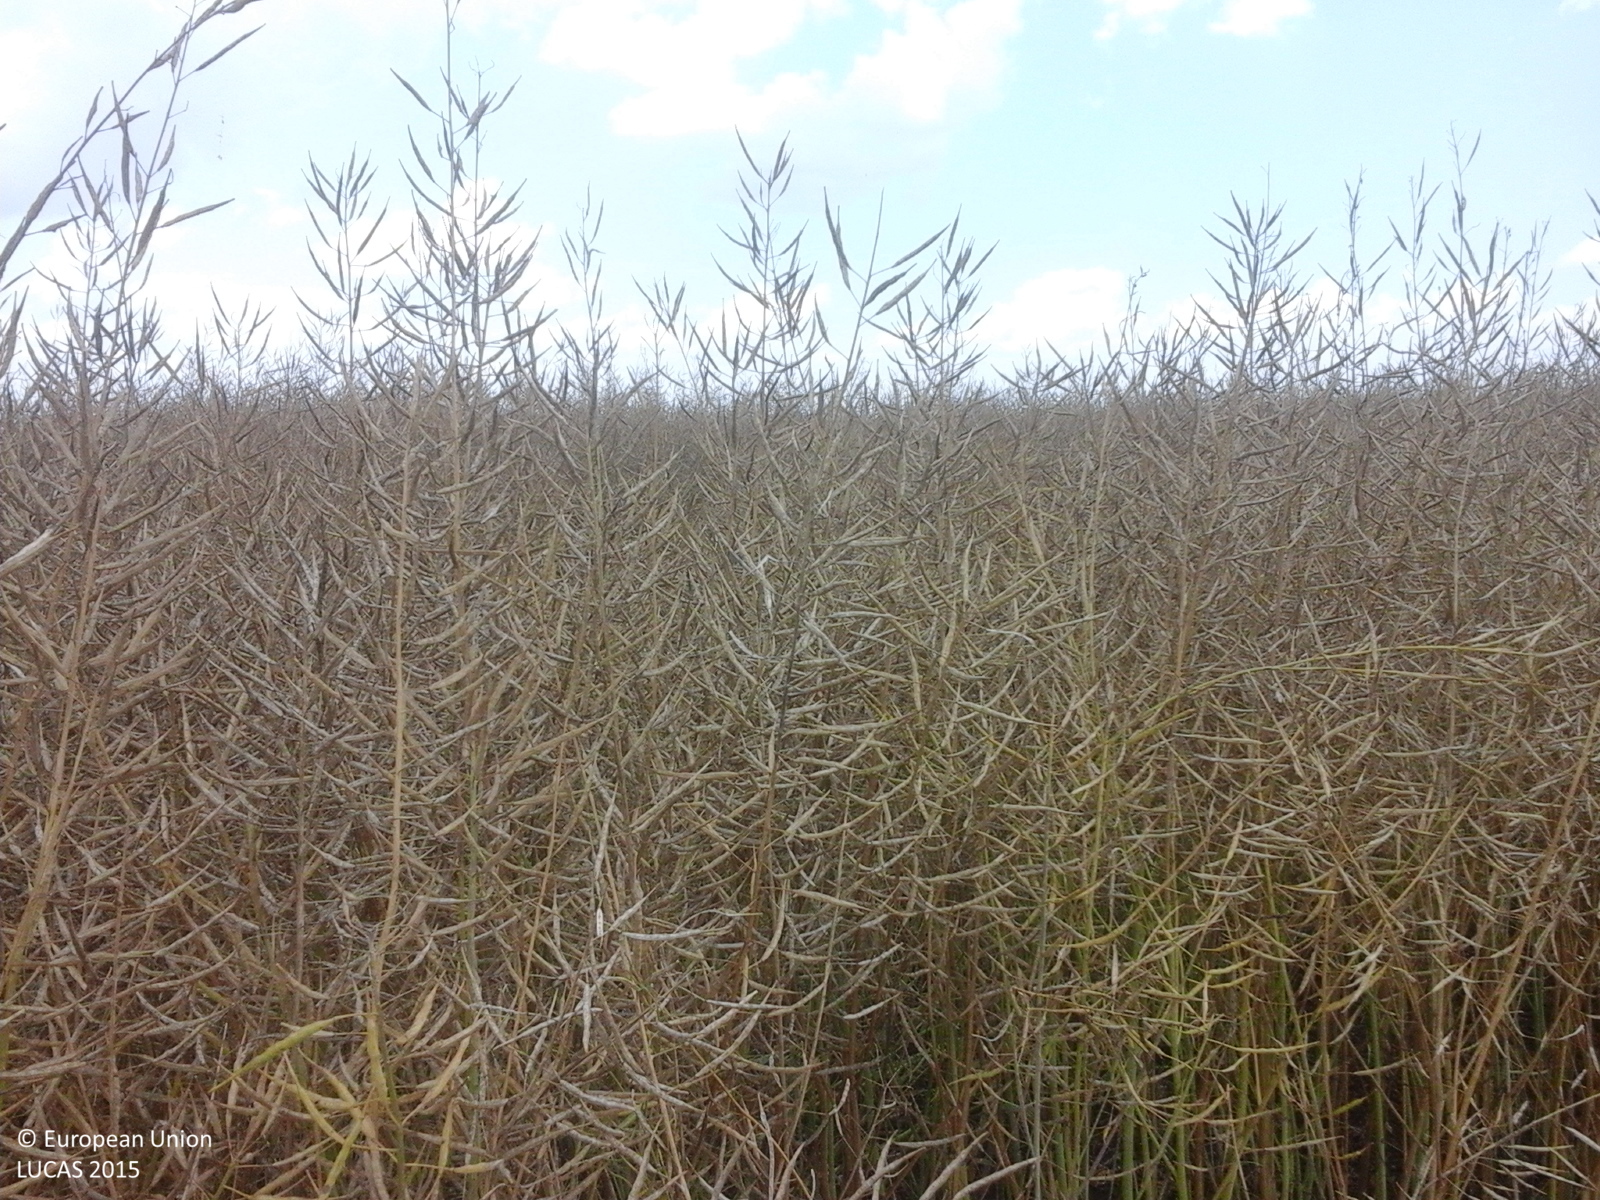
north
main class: Cropland
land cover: Rape and turnip rape
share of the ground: > 75 %
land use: Agriculture (excluding fallow land and kitchen gardens)
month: July
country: RO
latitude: 44.0772
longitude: 25.9693
